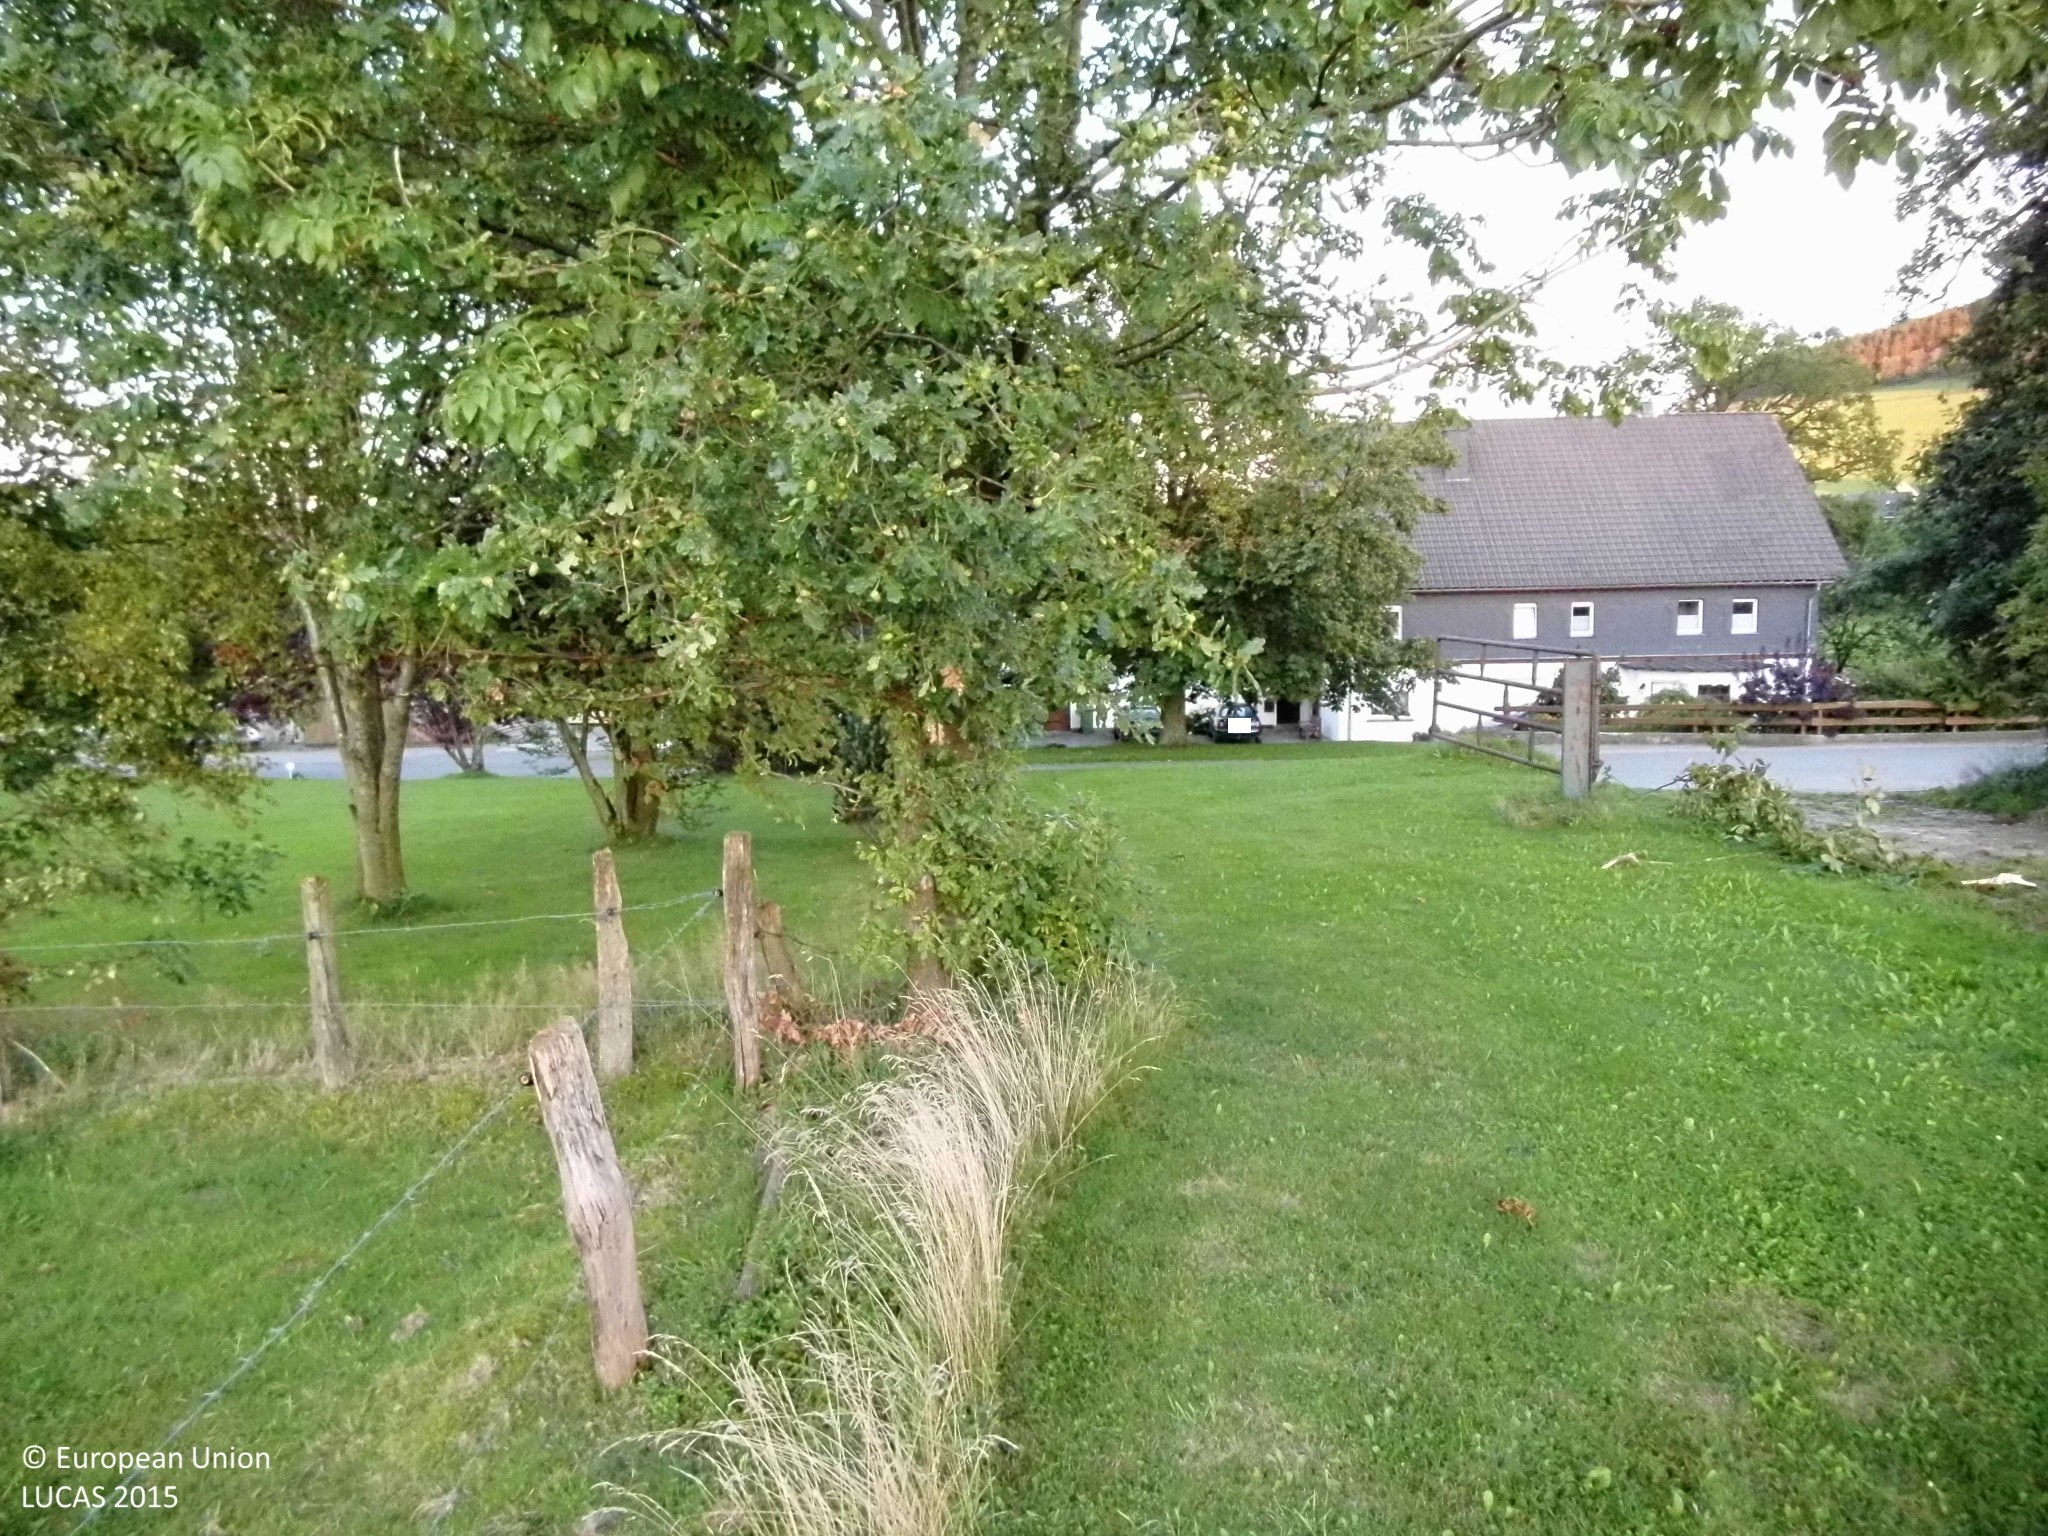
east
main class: Grassland
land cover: Grassland without tree/shrub cover
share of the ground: > 75 %
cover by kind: herbaceous plants 100 %
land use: Agriculture (excluding fallow land and kitchen gardens)
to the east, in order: Grassland without tree/shrub cover; Fences; Broadleaved woodland; Grassland without tree/shrub cover; Artificial constructions in urban areas; Grassland without tree/shrub cover; Electric lines; Grassland without tree/shrub cover; Fences; Grass margins; Fences; Grassland without tree/shrub cover; Electric lines; Grassland without tree/shrub cover; Rivers and streams; Grassland without tree/shrub cover
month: September
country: DE
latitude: 51.2525
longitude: 8.4386
